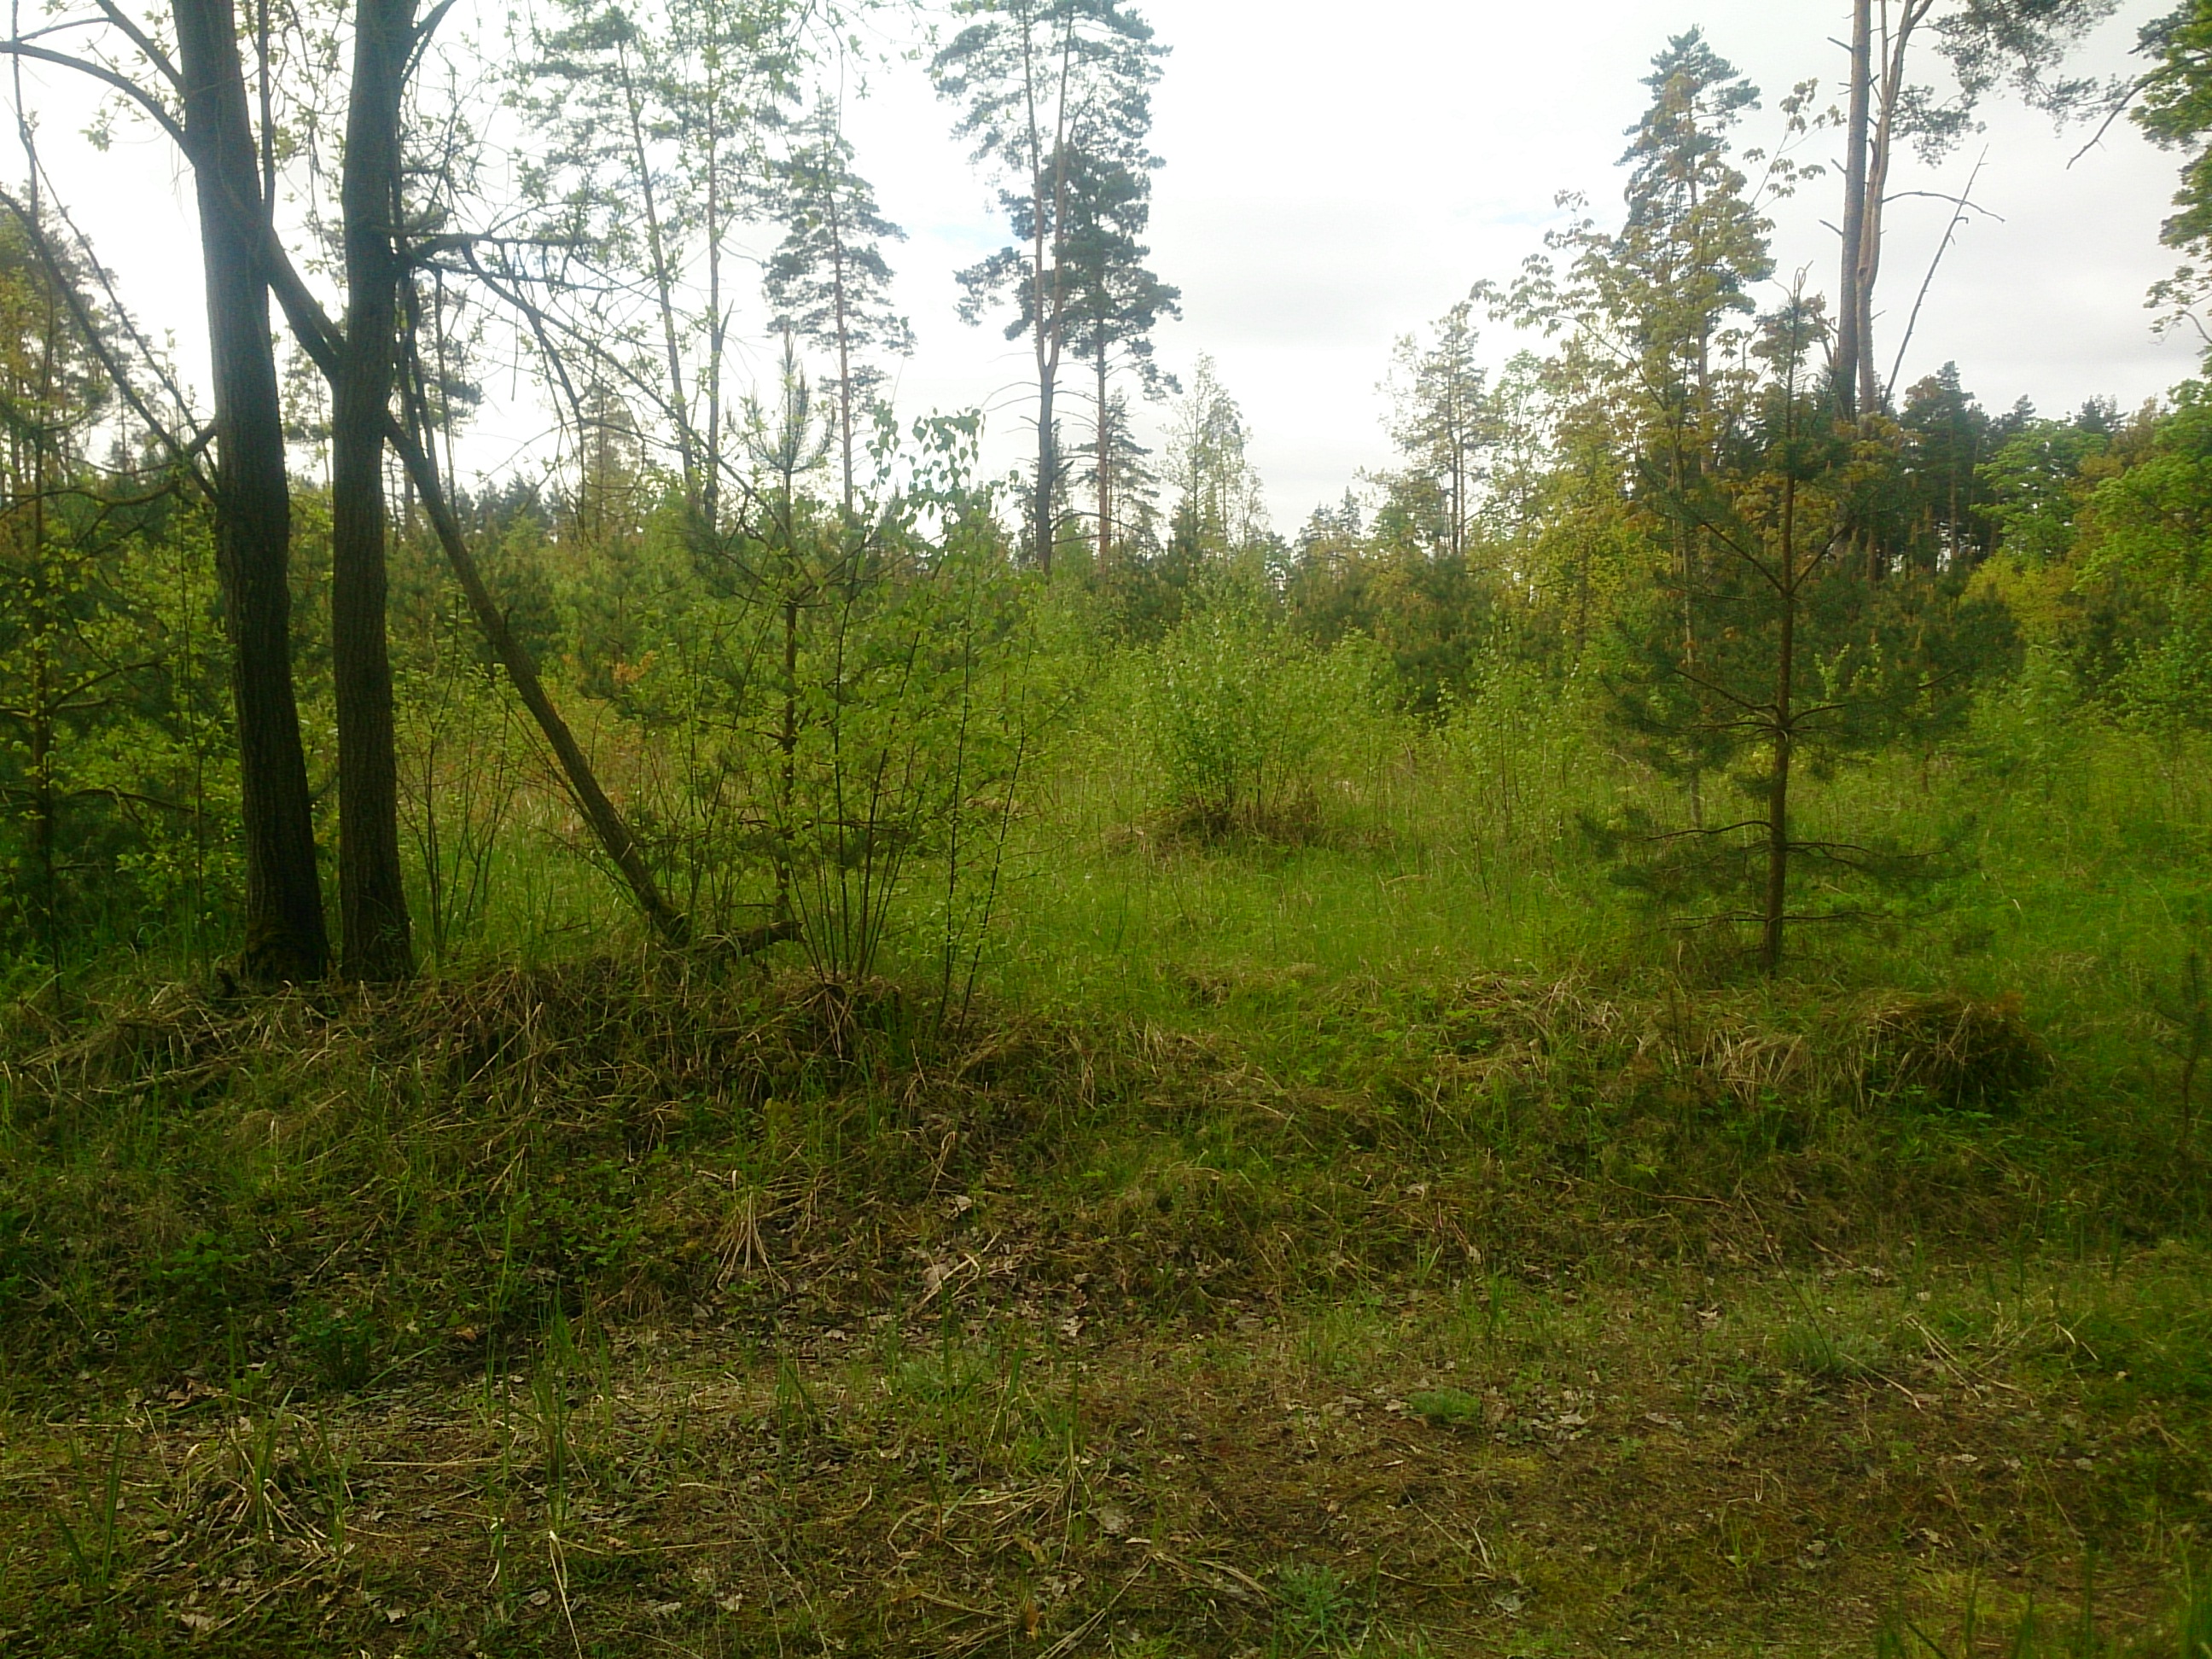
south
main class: Woodland
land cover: Pine dominated mixed woodland
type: hemiboreal forest and nemoral coniferous forest and mixed broadleaved-coniferous forest
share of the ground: > 75 %
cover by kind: coniferous forest trees 60 %, broadleaved forest trees 25 %, herbaceous plants 10 %, lichens and mosses 5 %
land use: Forestry
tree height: > 5 m
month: May
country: LV
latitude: 56.6689
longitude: 24.2371
